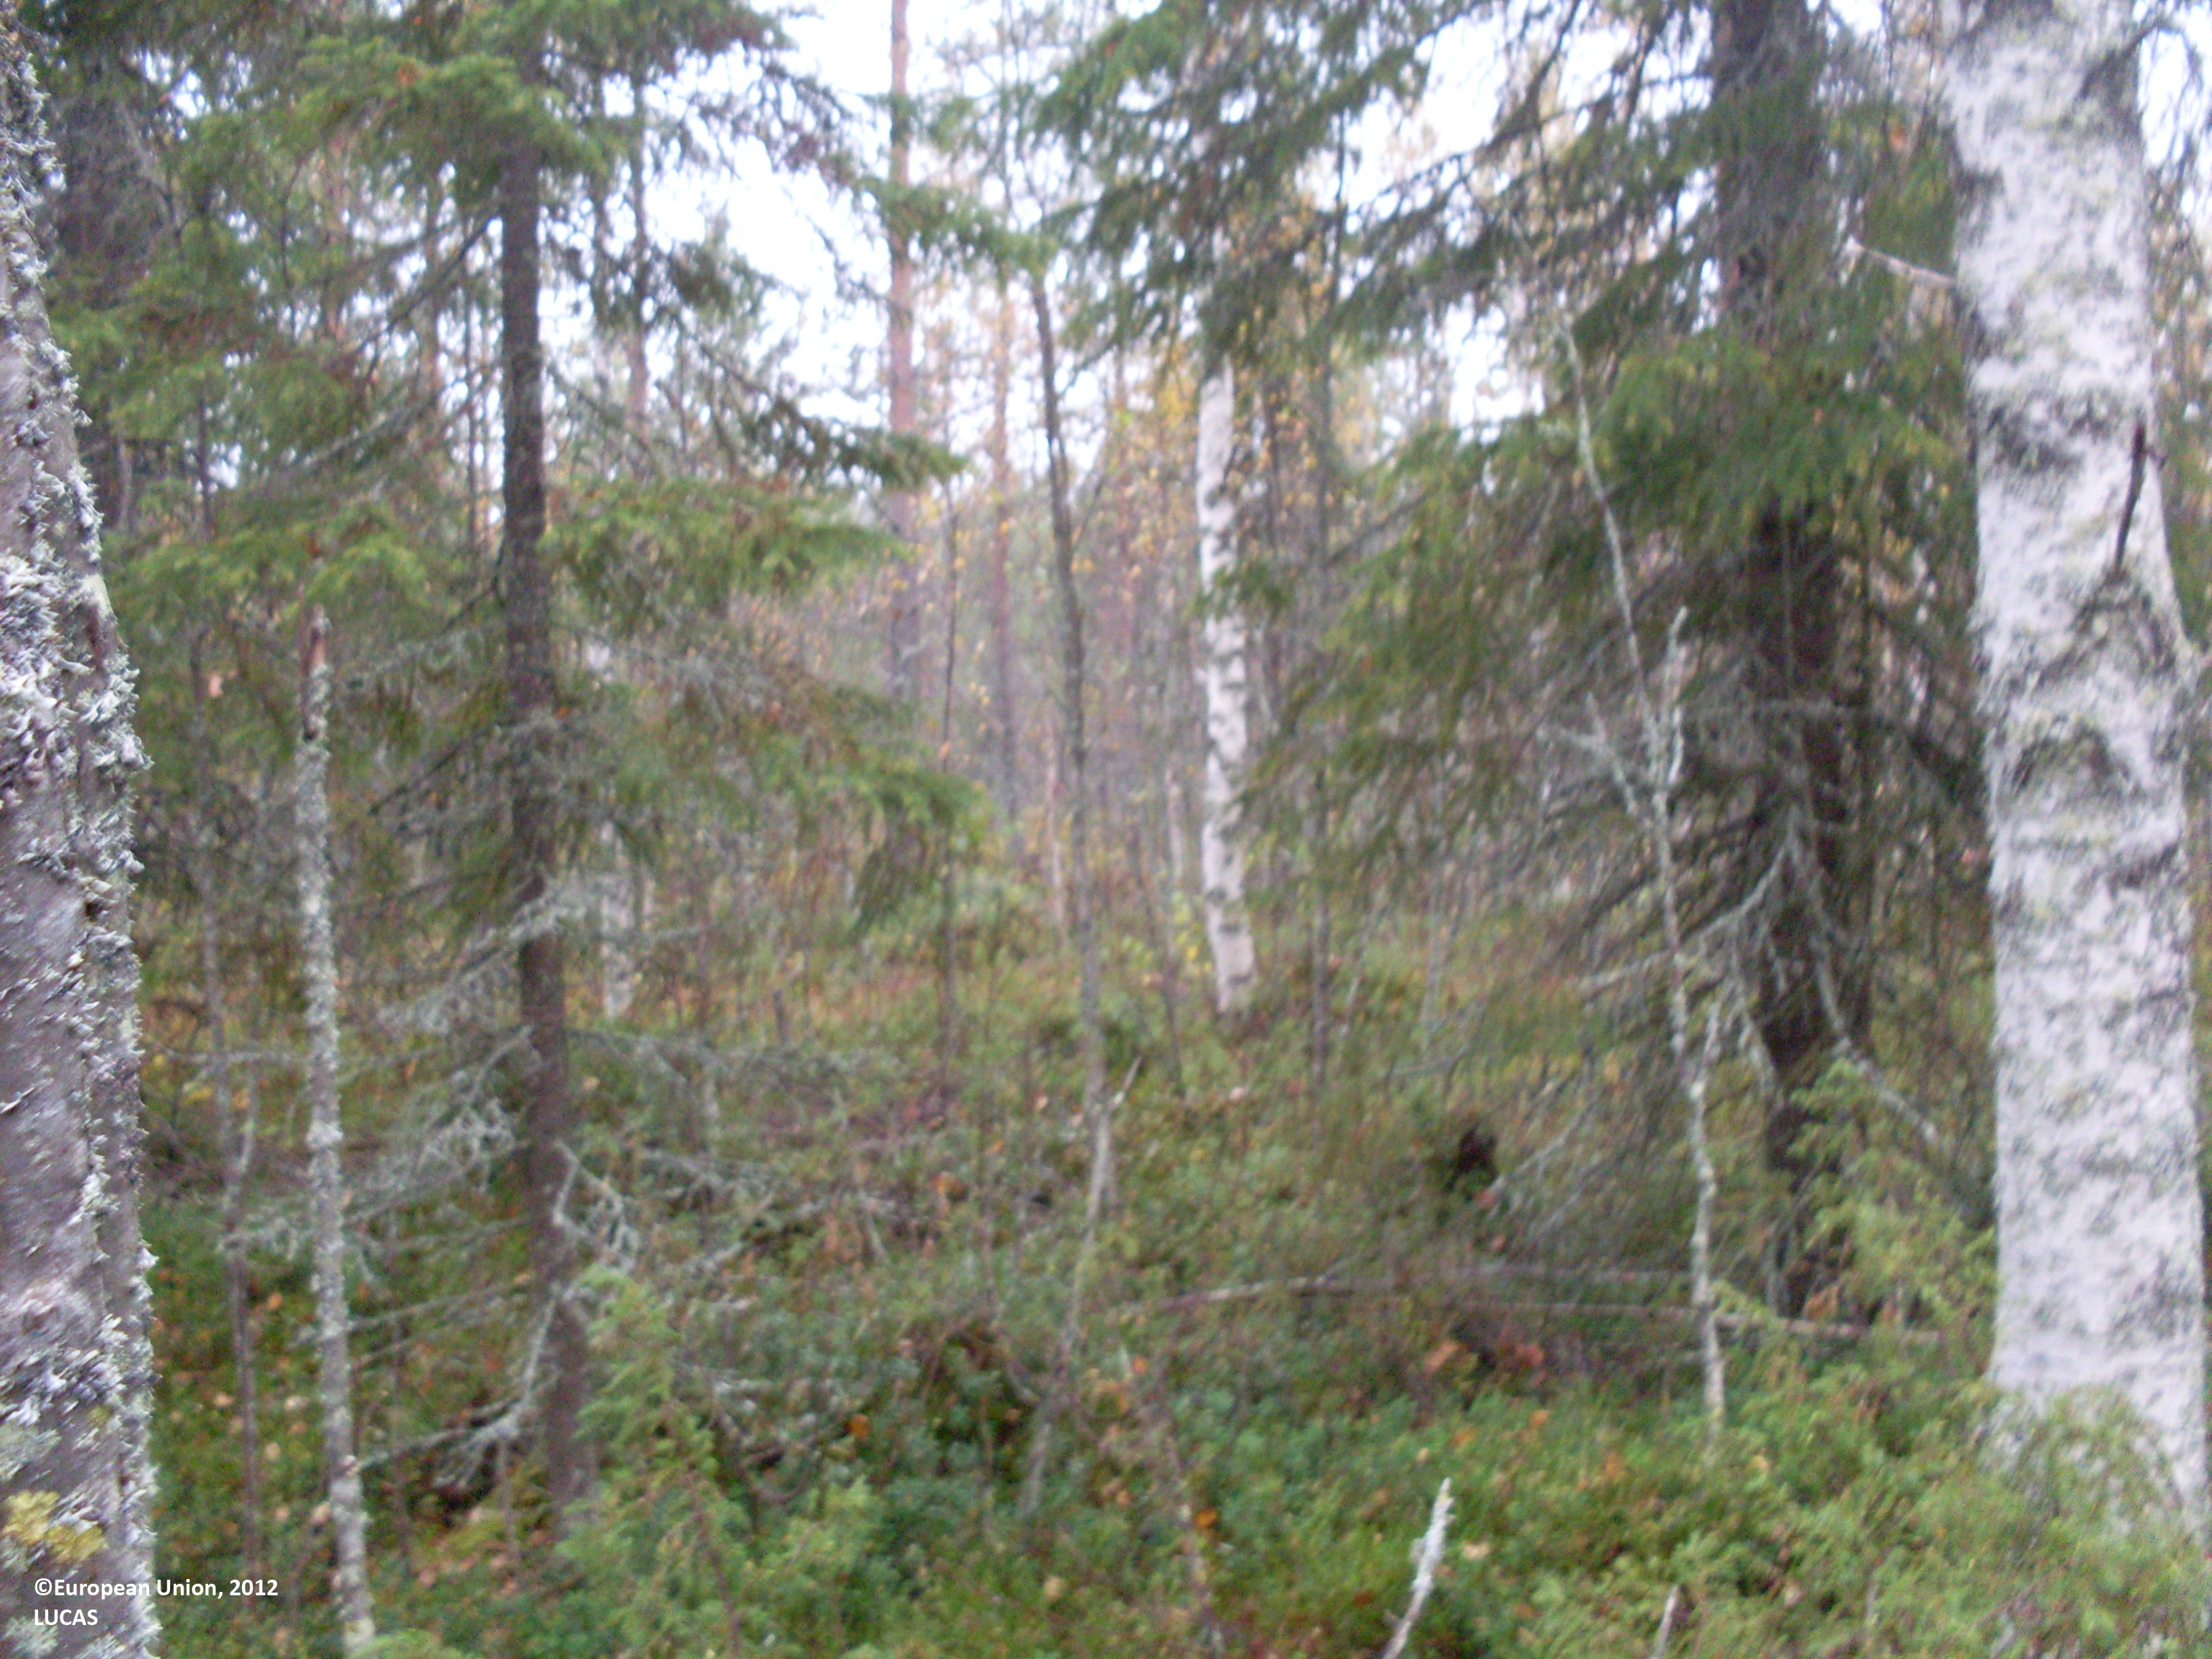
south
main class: Woodland
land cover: Spruce dominated mixed woodland
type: boreal forest
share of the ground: 50 - 75 %
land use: Forestry
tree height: > 5 m
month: September
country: FI
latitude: 64.3080
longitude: 29.3757
